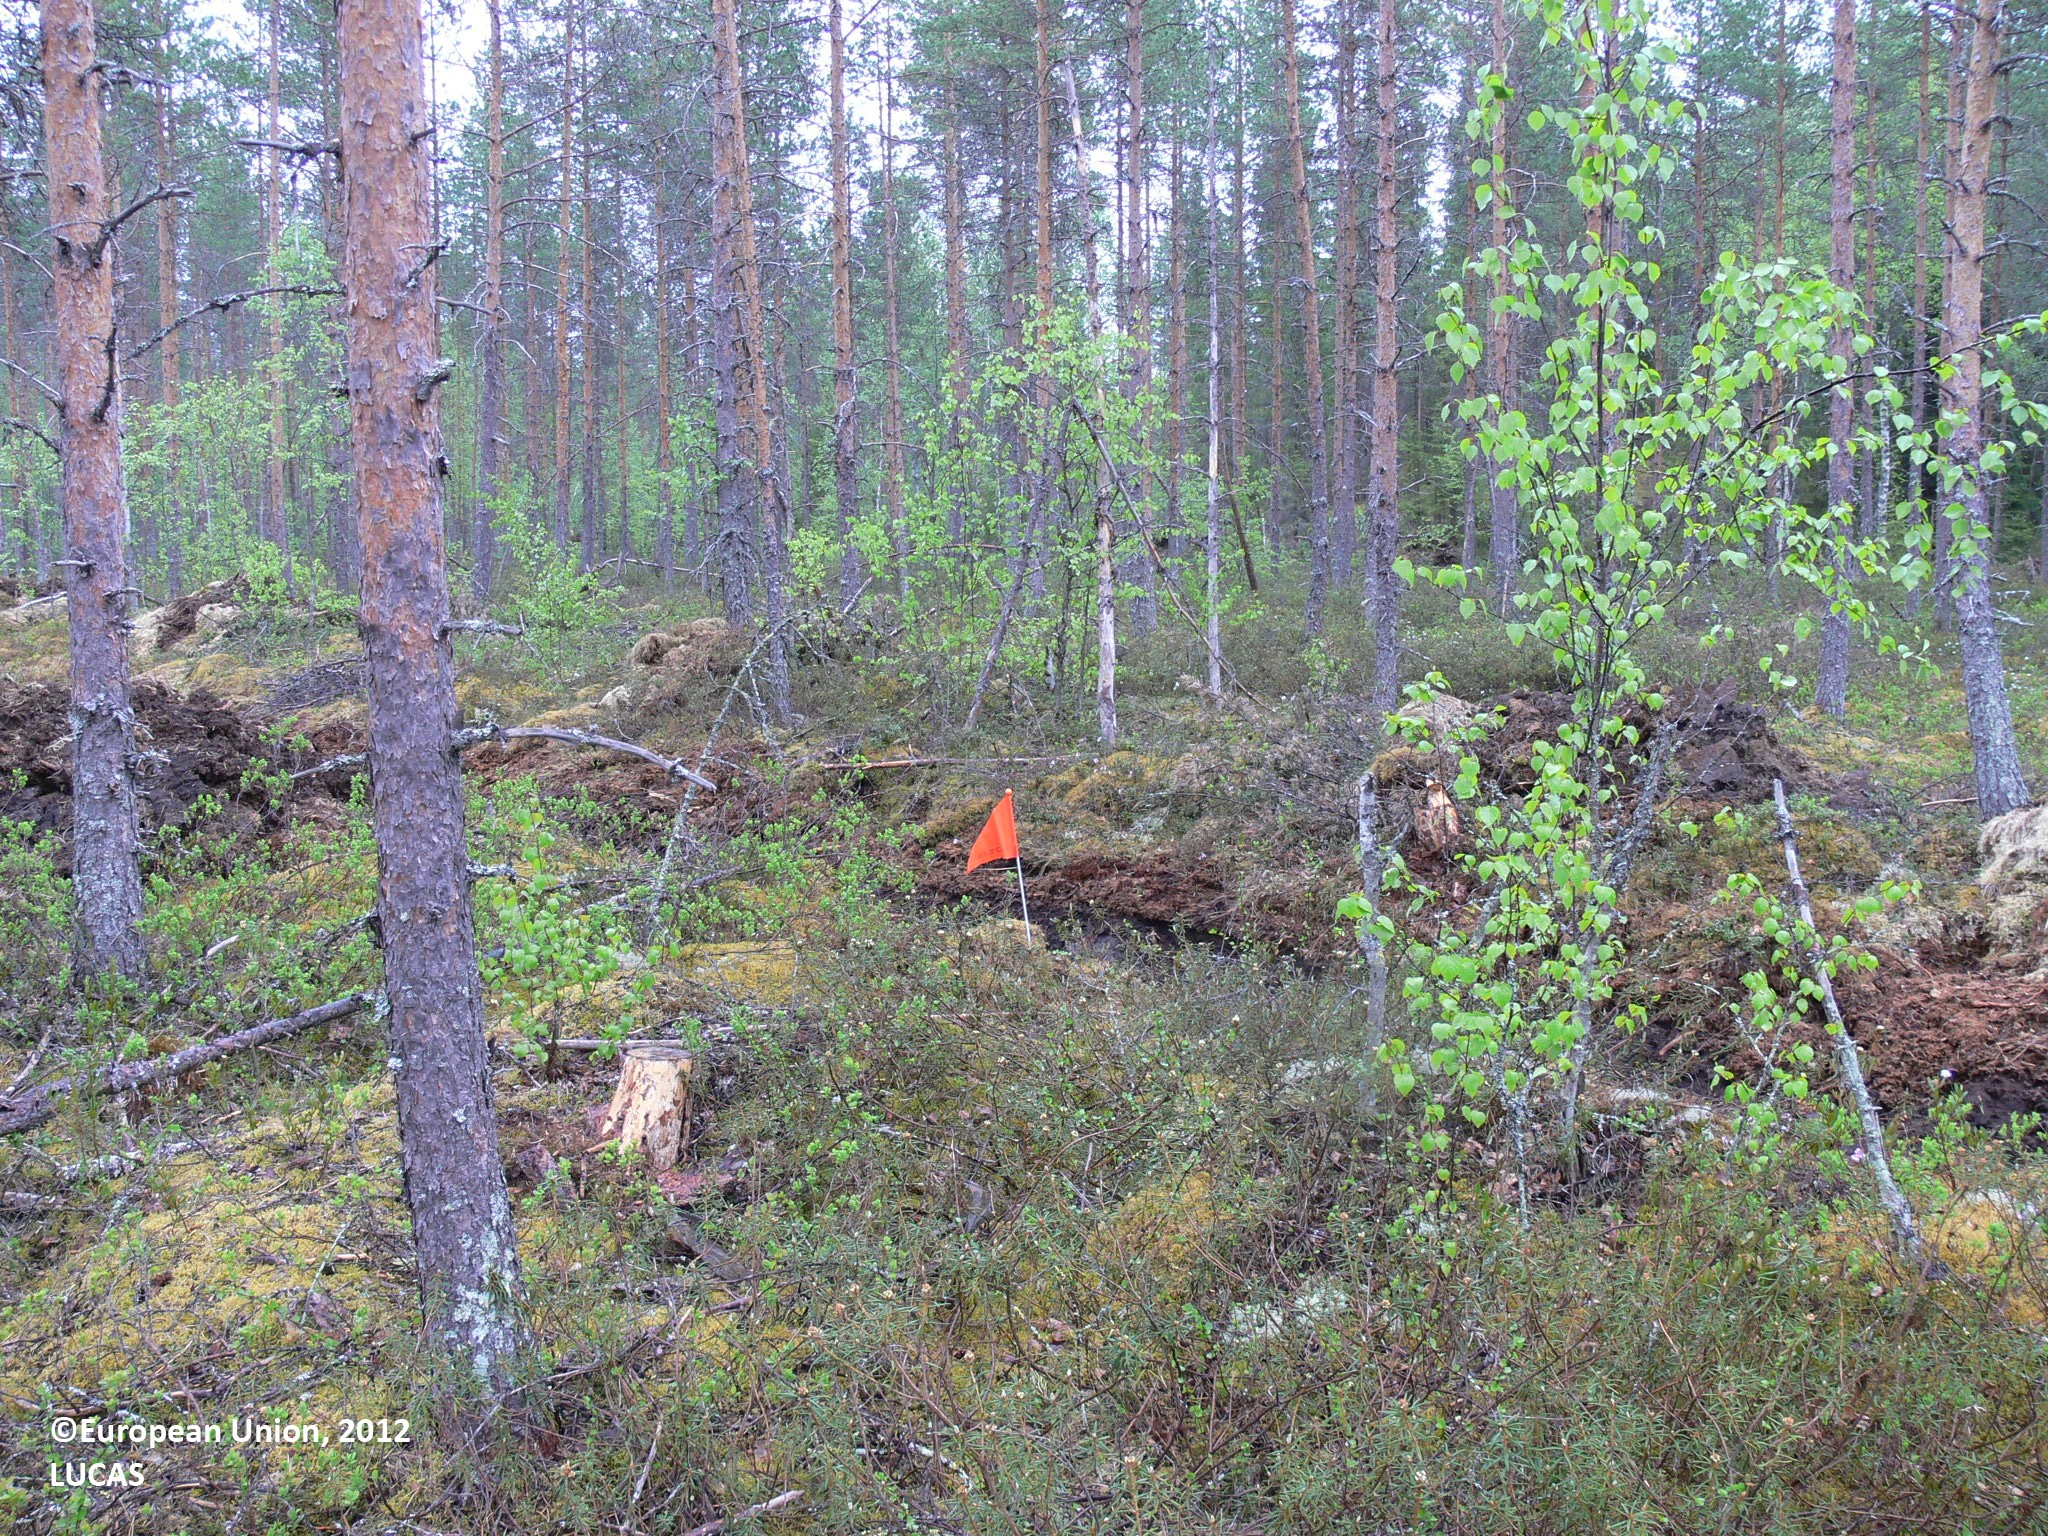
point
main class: Woodland
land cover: Pine dominated coniferous woodland
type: boreal forest
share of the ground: > 75 %
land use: Forestry
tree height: > 5 m
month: June
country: FI
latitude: 62.2268
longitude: 30.2219
